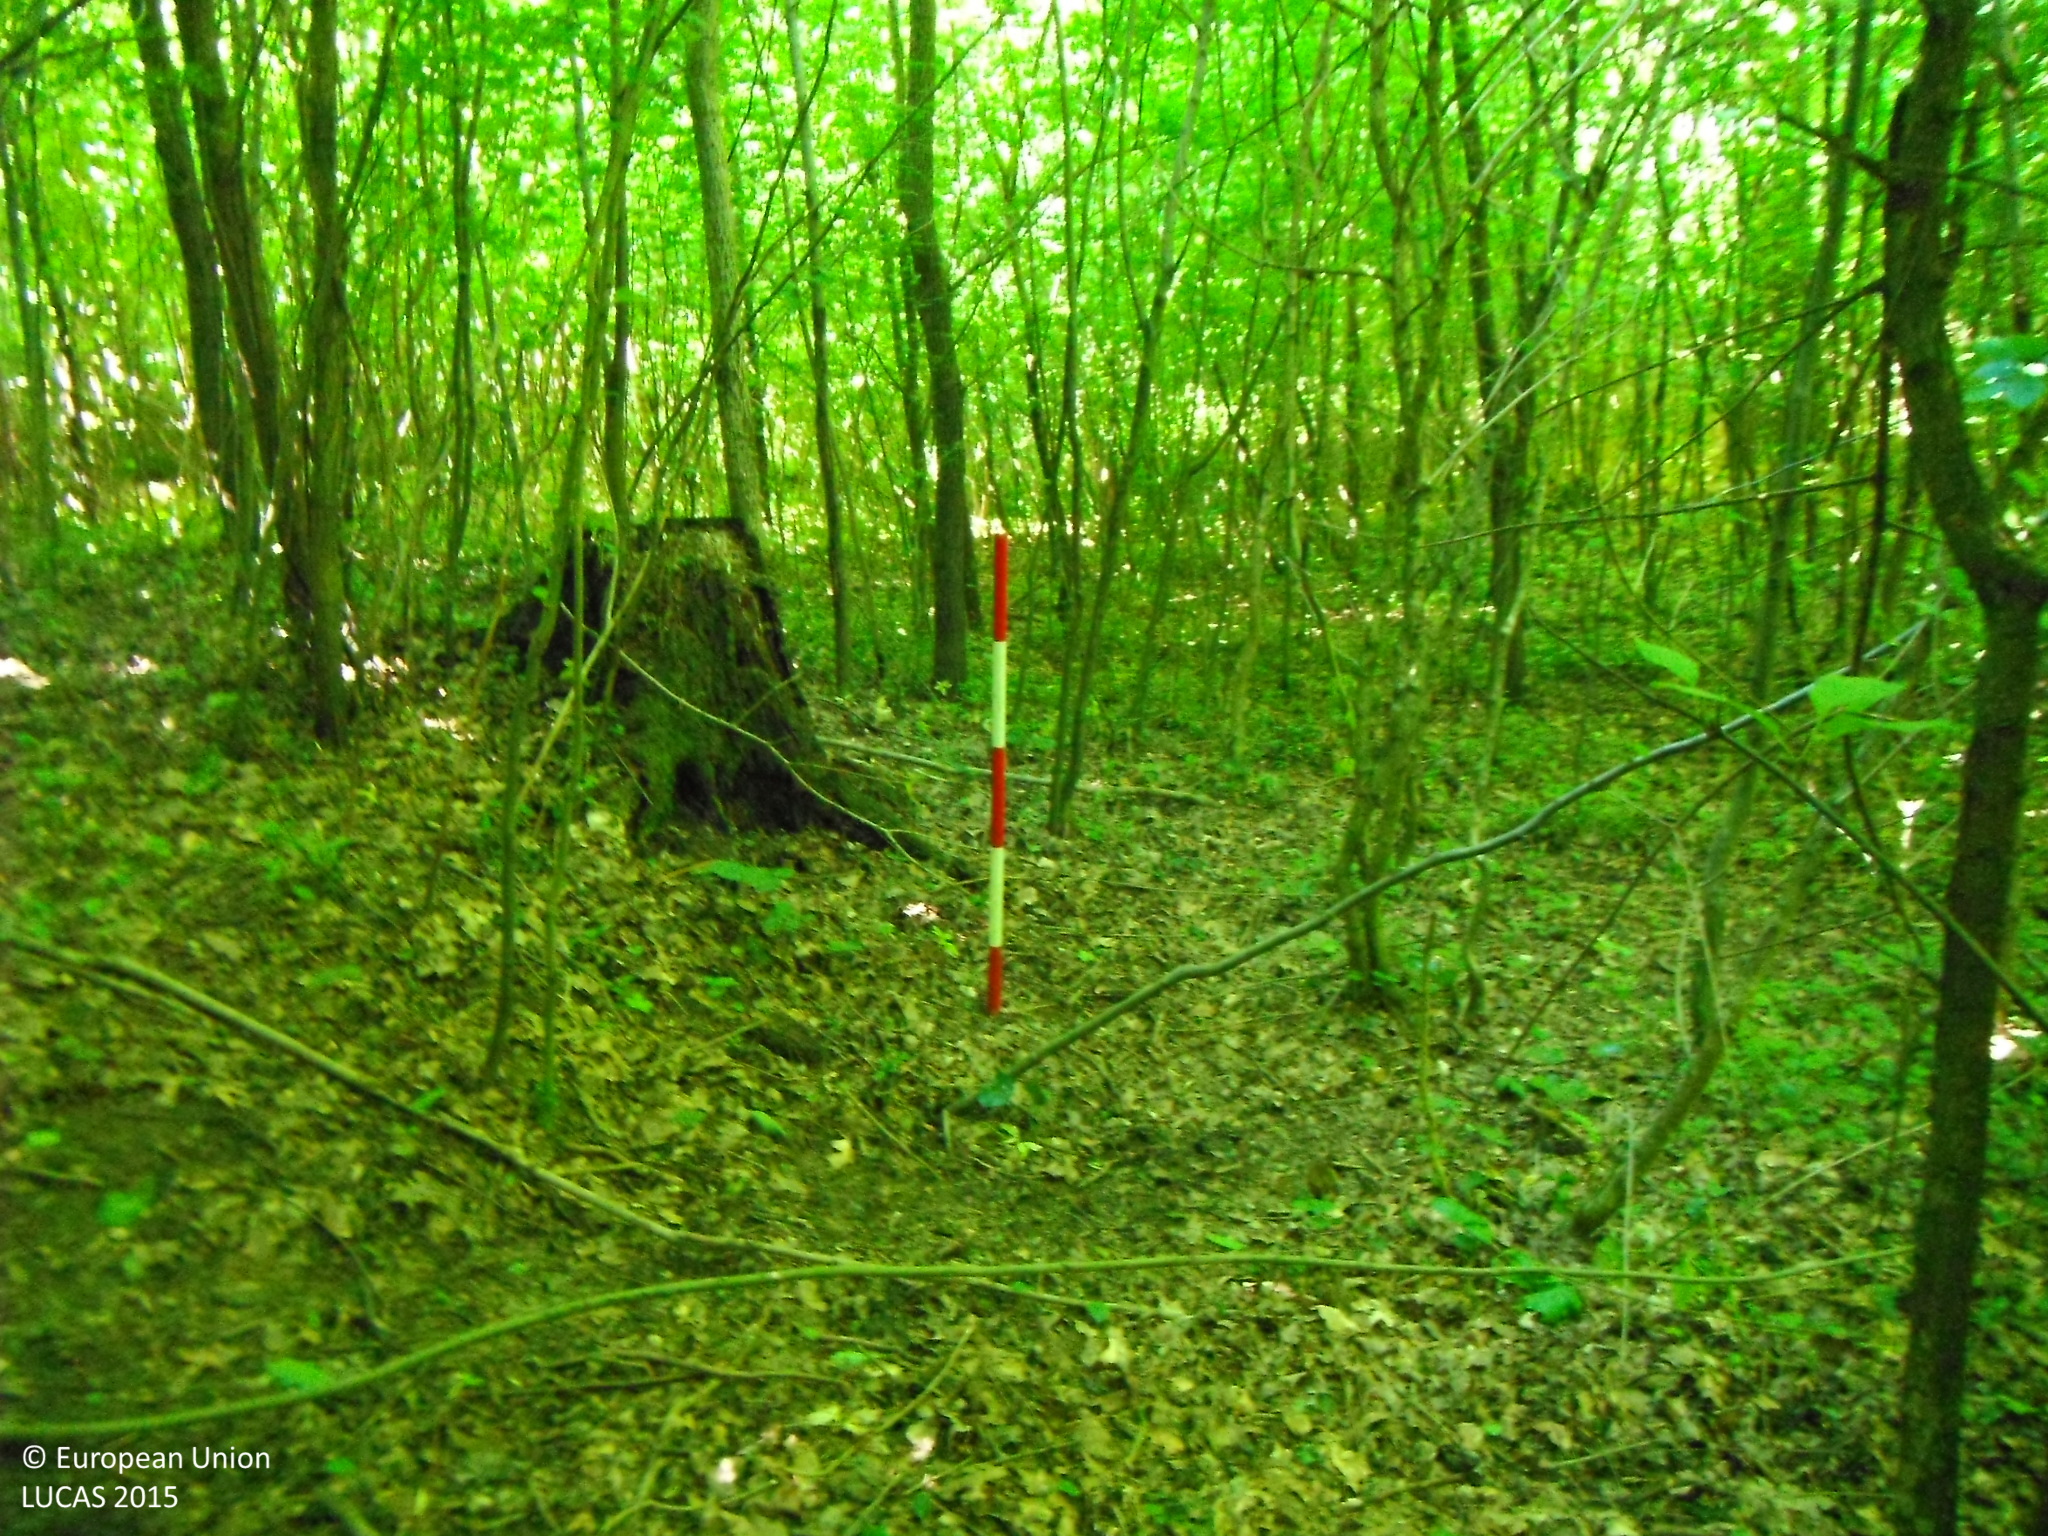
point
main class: Woodland
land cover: Broadleaved woodland
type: mesophytic deciduous forest
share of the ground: > 75 %
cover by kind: broadleaved forest trees 100 %
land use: Forestry
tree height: > 5 m
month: June
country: SK
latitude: 48.8941
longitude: 21.2984
